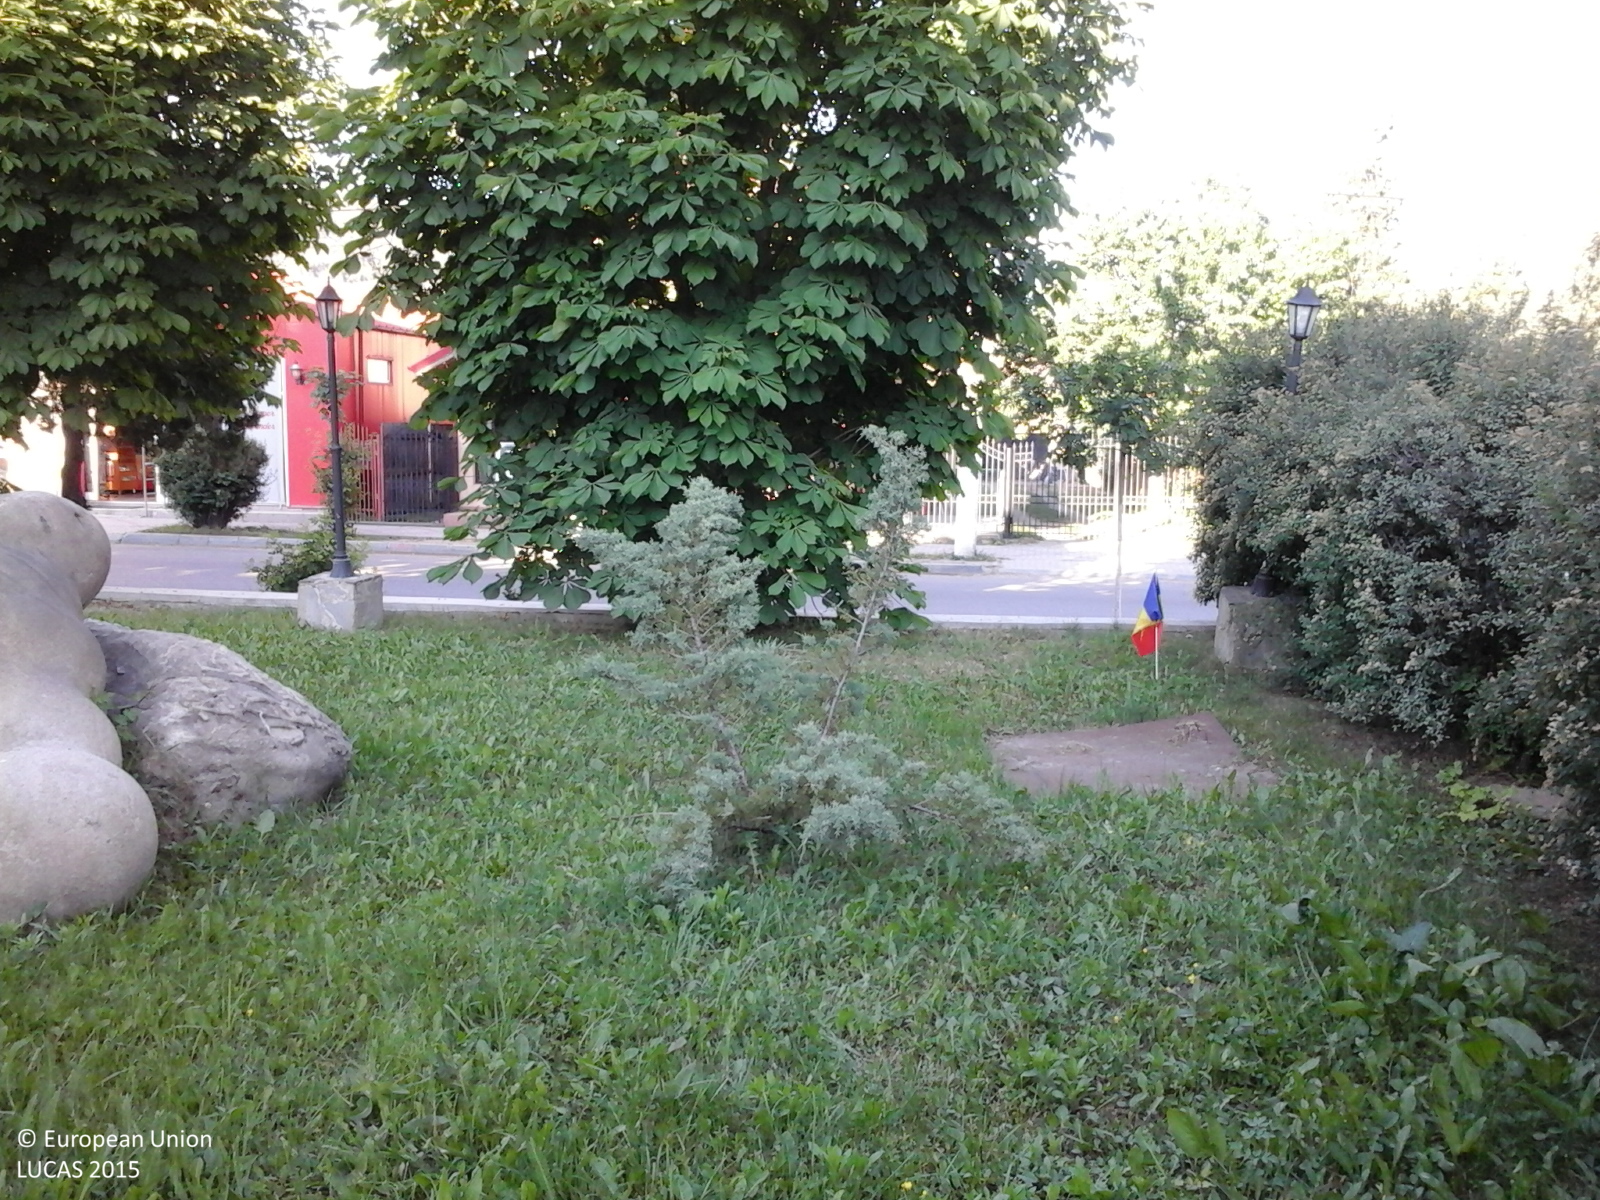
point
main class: Grassland
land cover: Grassland with sparse tree/shrub cover
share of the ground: > 75 %
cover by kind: herbaceous plants 95 %, broadleaved forest trees 5 %
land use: Amenities, museums, leisure
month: May
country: RO
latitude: 45.3194
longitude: 26.3598
